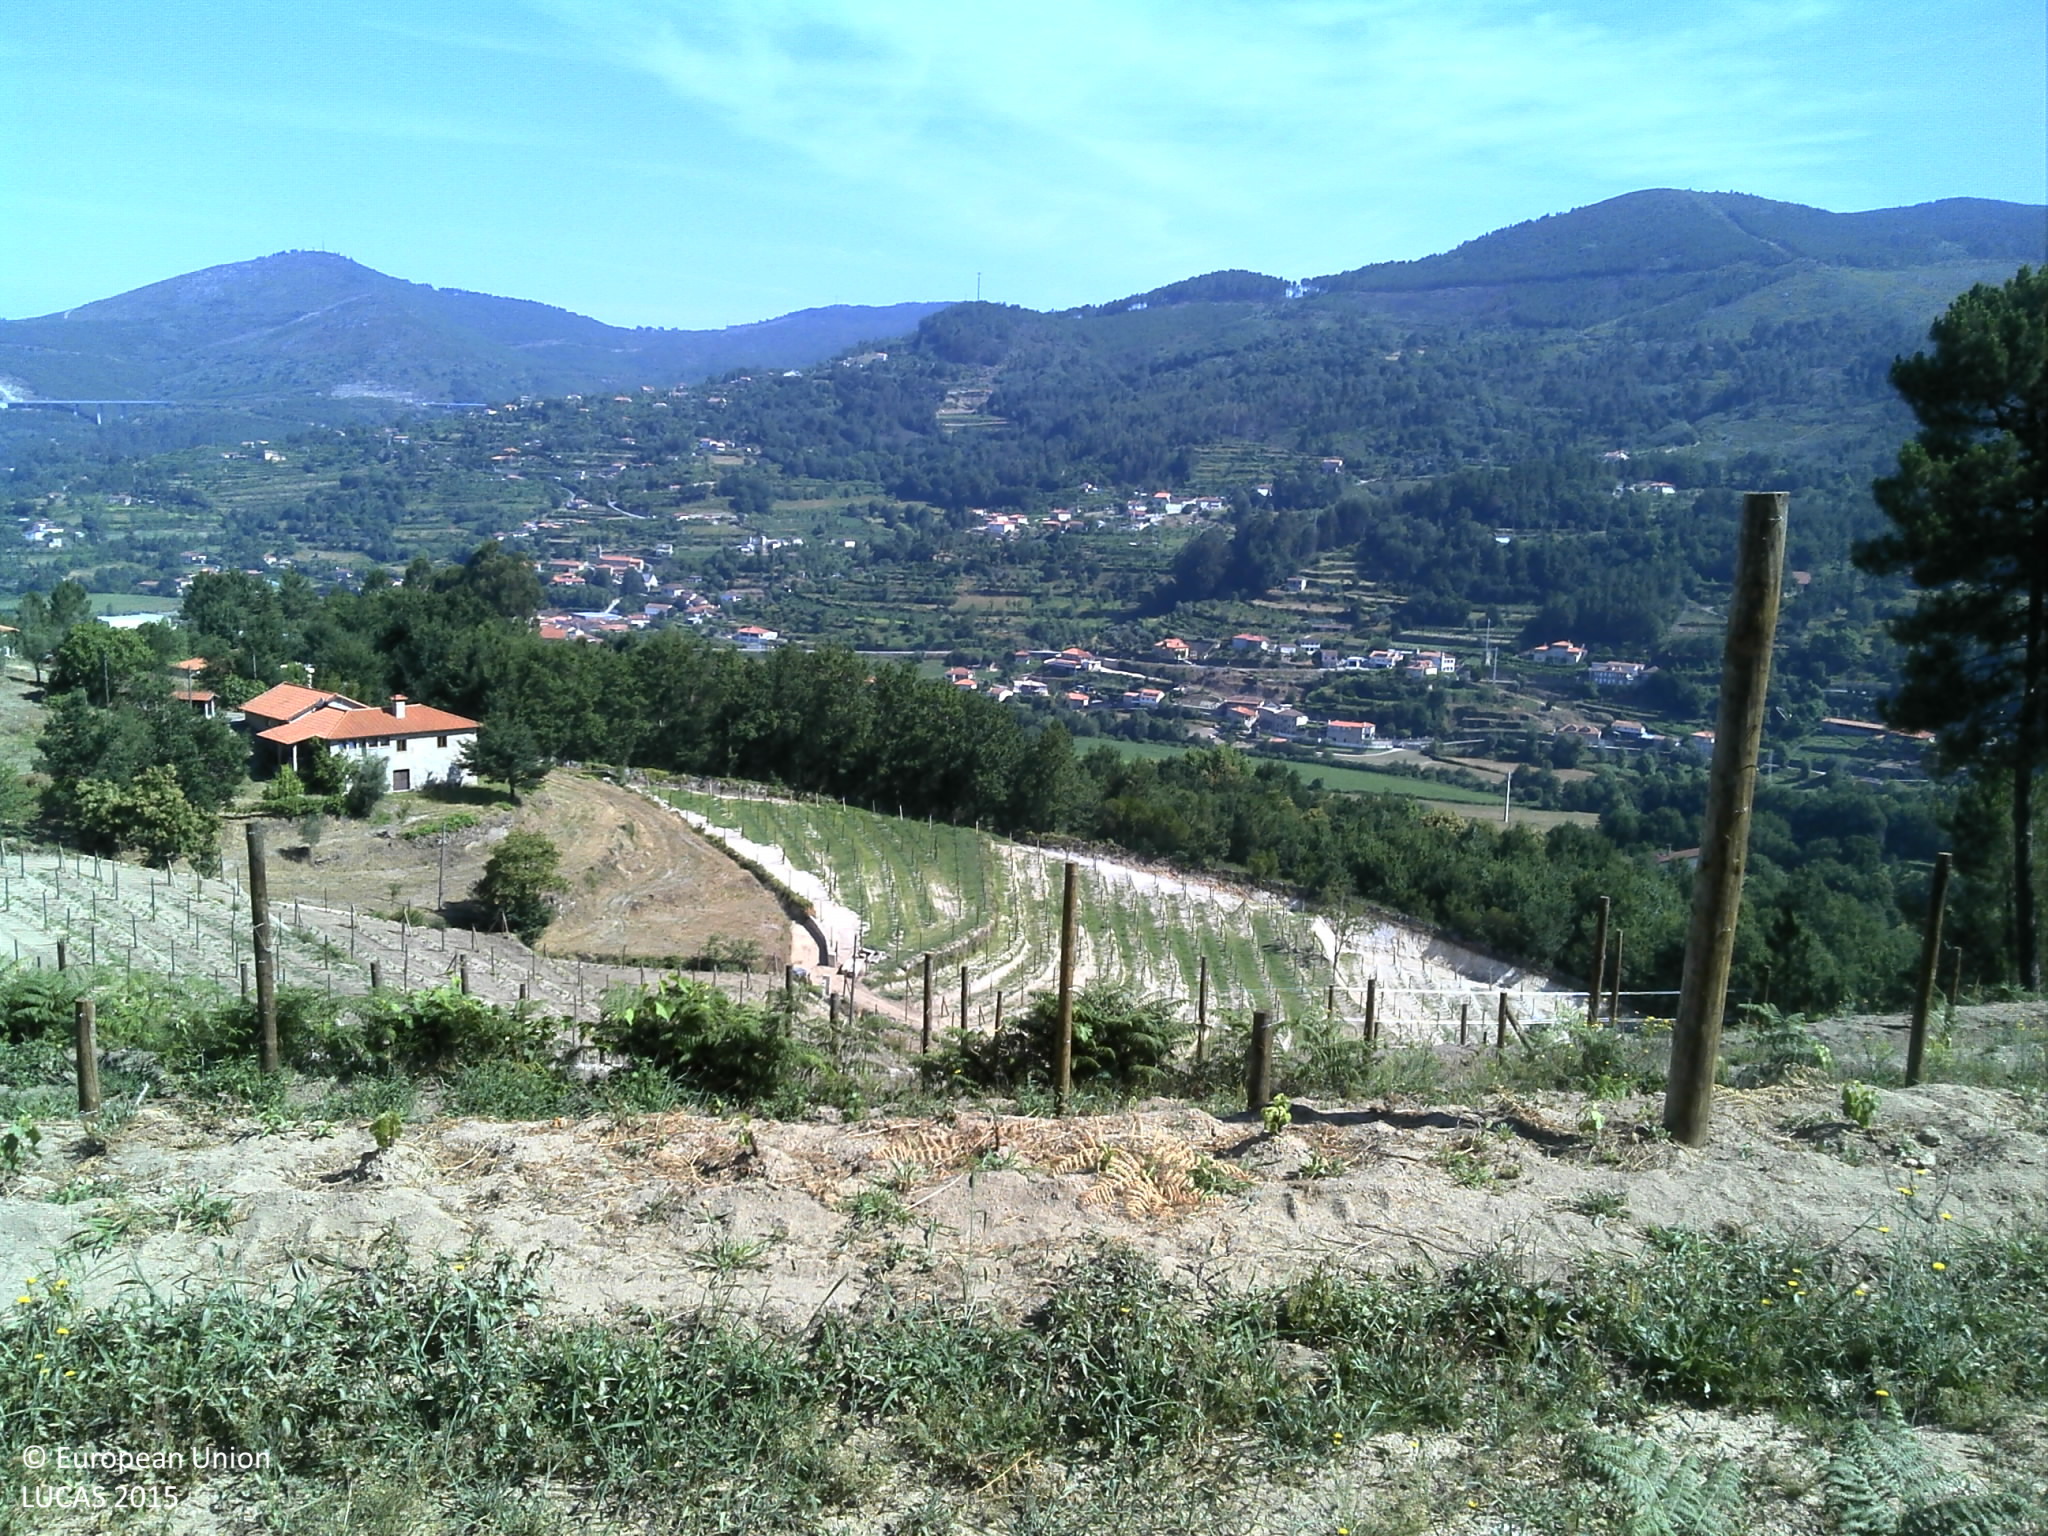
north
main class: Cropland
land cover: Vineyards
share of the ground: < 10 %
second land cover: Grassland without tree/shrub cover
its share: 25 - 50 %
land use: Agriculture (excluding fallow land and kitchen gardens)
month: July
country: PT
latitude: 41.4605
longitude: -7.8427
